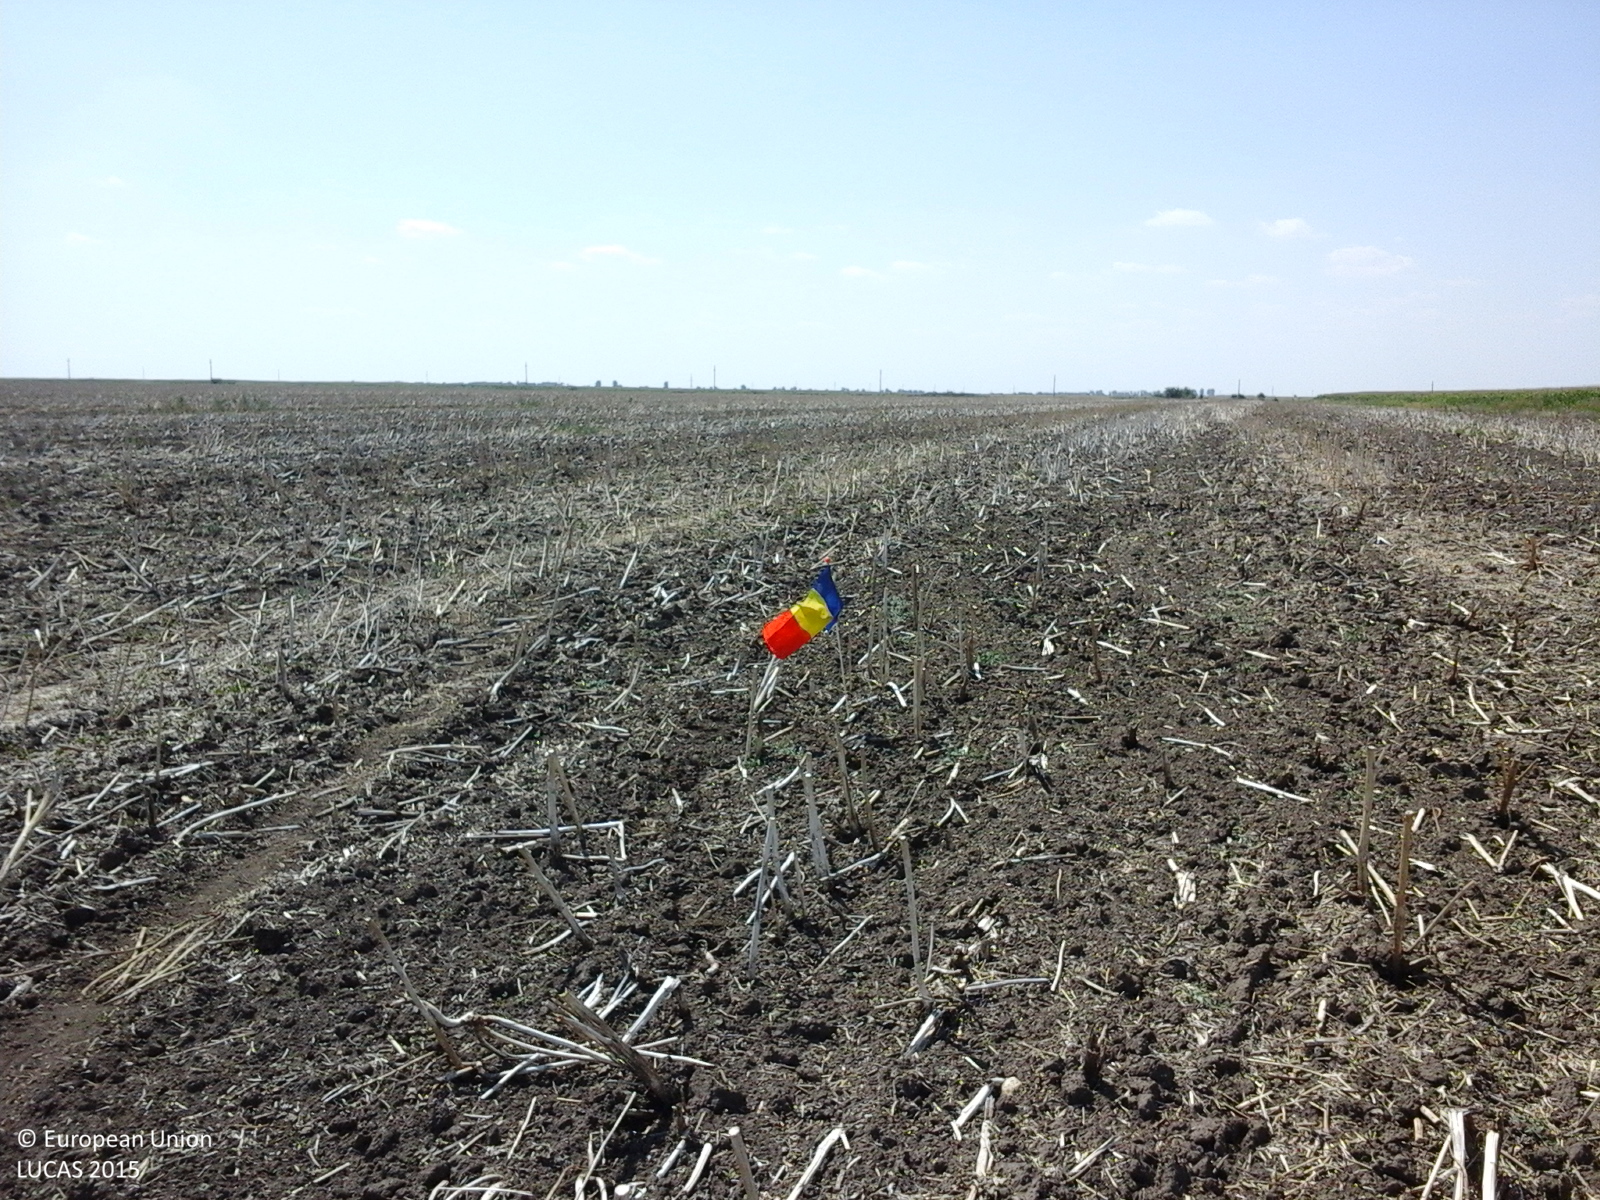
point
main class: Cropland
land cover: Rape and turnip rape
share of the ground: < 10 %
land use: Agriculture (excluding fallow land and kitchen gardens)
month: July
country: RO
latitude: 44.2860
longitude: 26.9547
